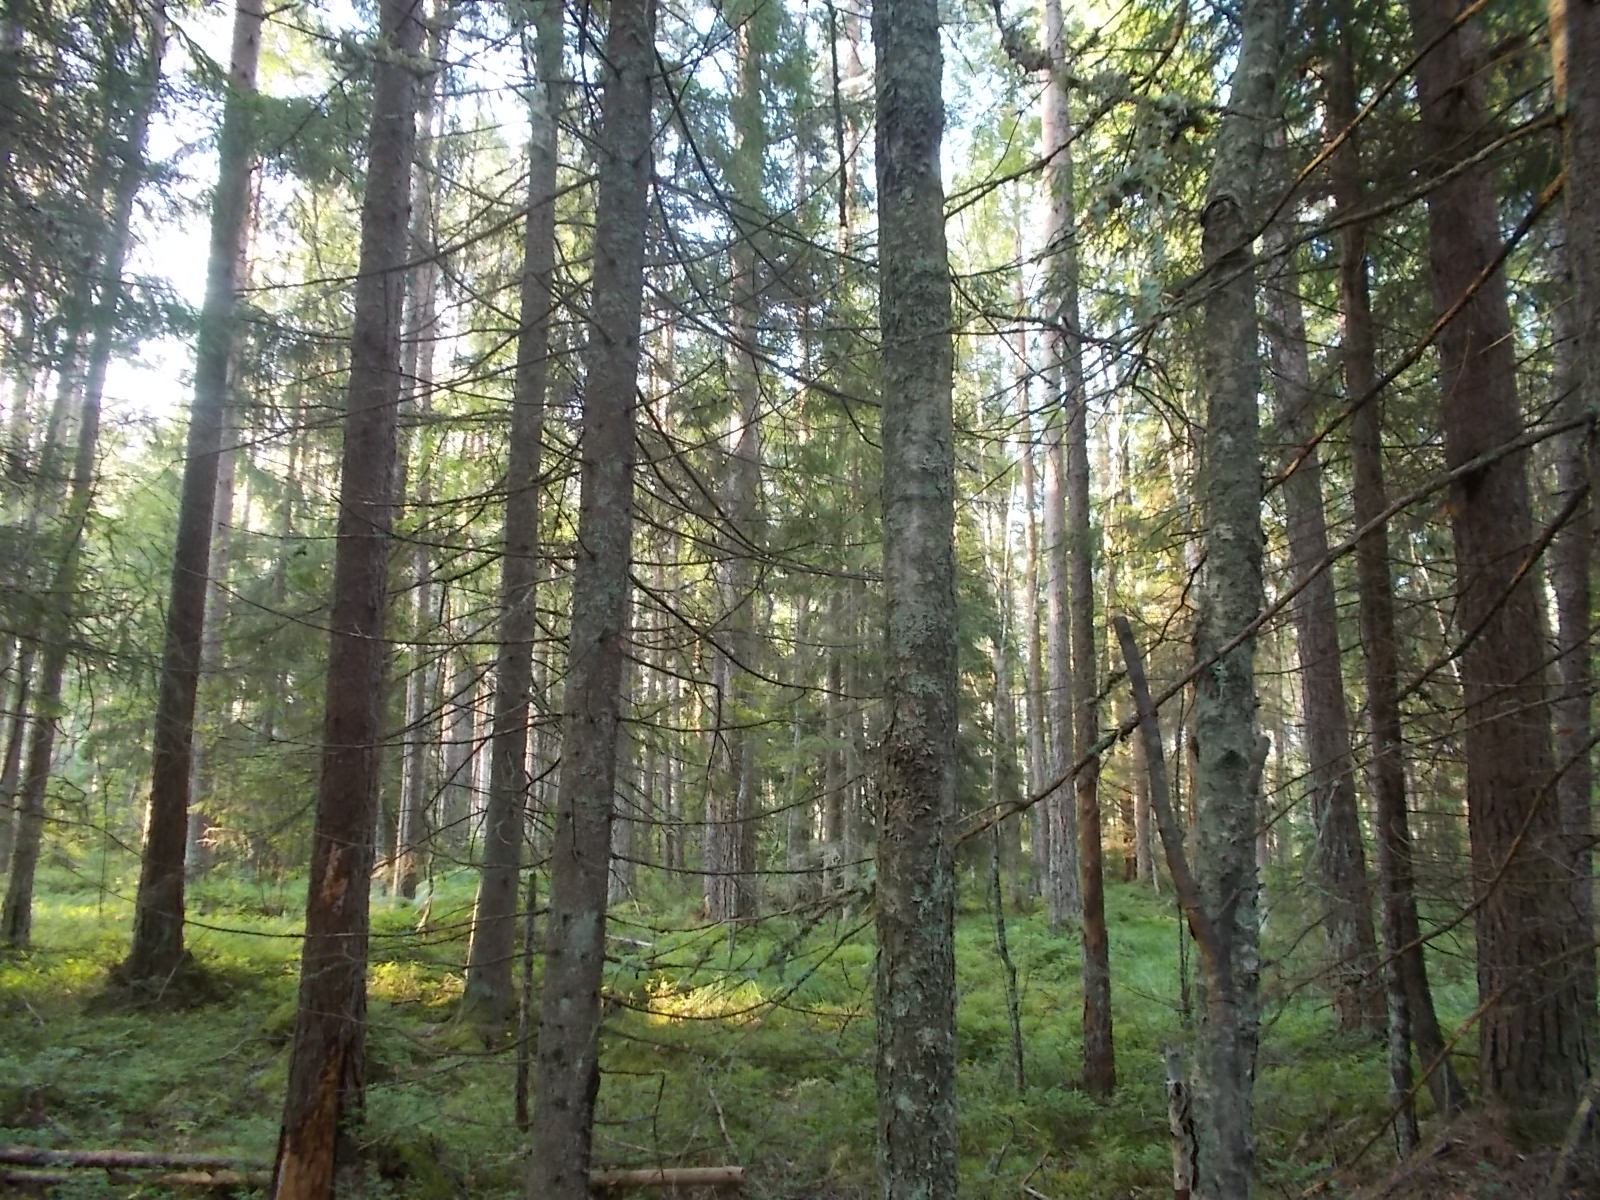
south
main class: Woodland
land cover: Other coniferous woodland
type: hemiboreal forest and nemoral coniferous forest and mixed broadleaved-coniferous forest
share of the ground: 50 - 75 %
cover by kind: coniferous forest trees 65 %, shrubs 10 %, herbaceous plants 10 %, lichens and mosses 10 %, broadleaved forest trees 5 %
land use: Forestry
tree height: > 5 m
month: August
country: LV
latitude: 57.0511
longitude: 21.4973
